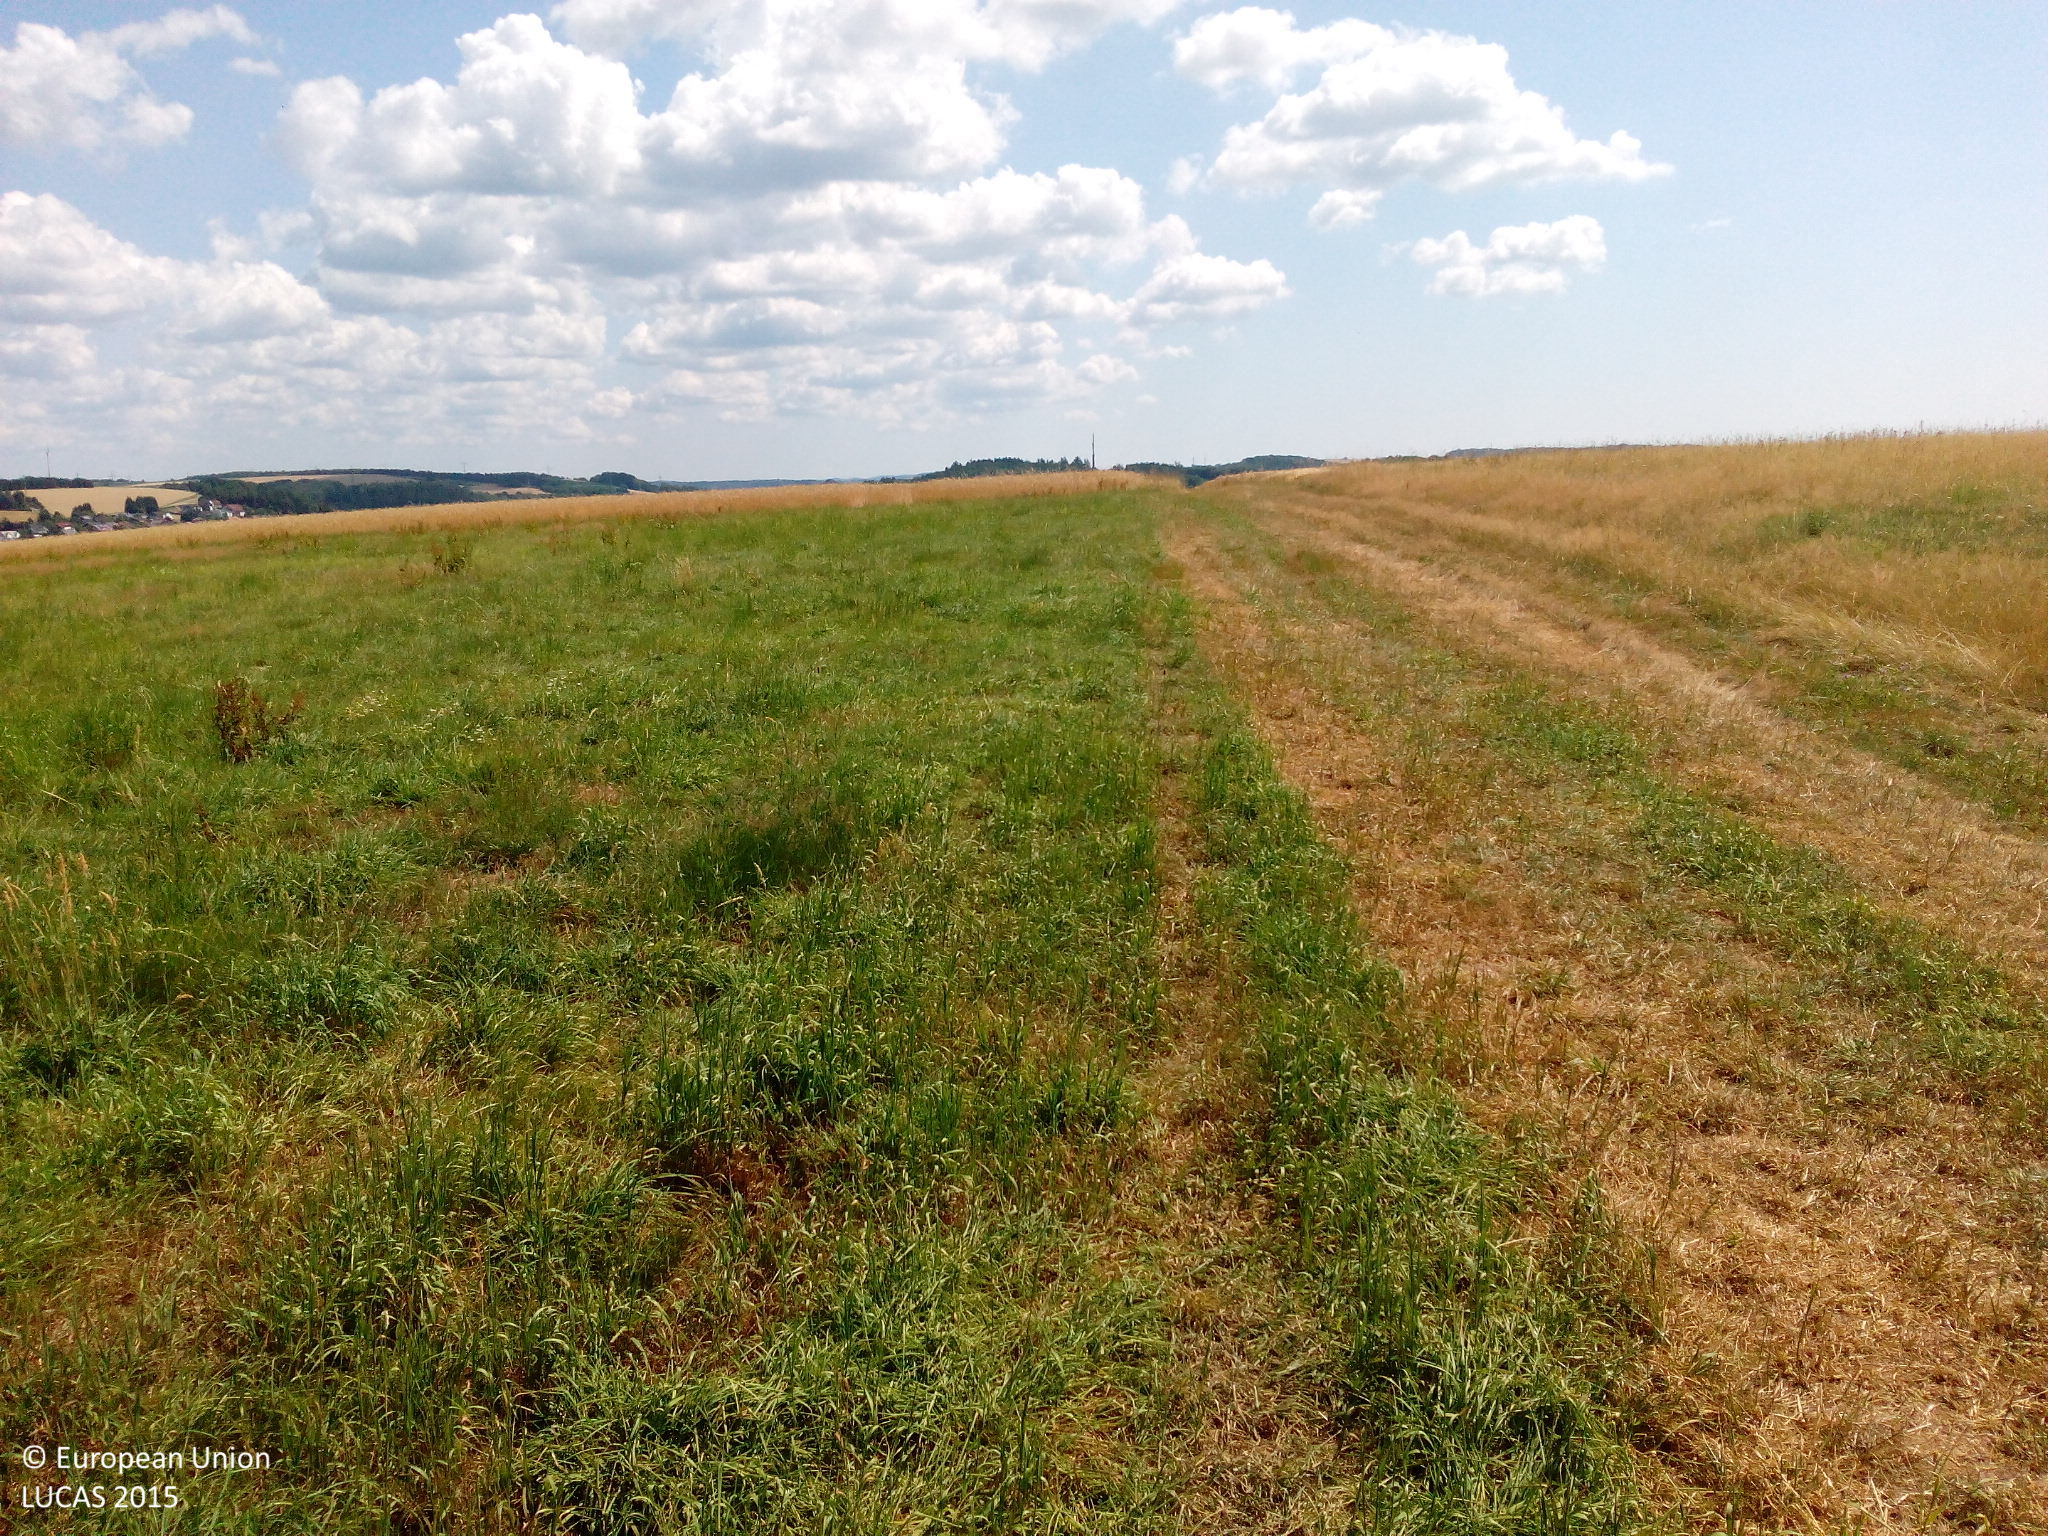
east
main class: Grassland
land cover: Grassland without tree/shrub cover
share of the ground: > 75 %
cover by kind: herbaceous plants 85 %, unconsolidated bare surface 15 %
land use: Agriculture (excluding fallow land and kitchen gardens)
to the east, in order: Grassland without tree/shrub cover; Tracks; Barley; Grassland without tree/shrub cover
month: July
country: DE
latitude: 49.2587
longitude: 7.5685
